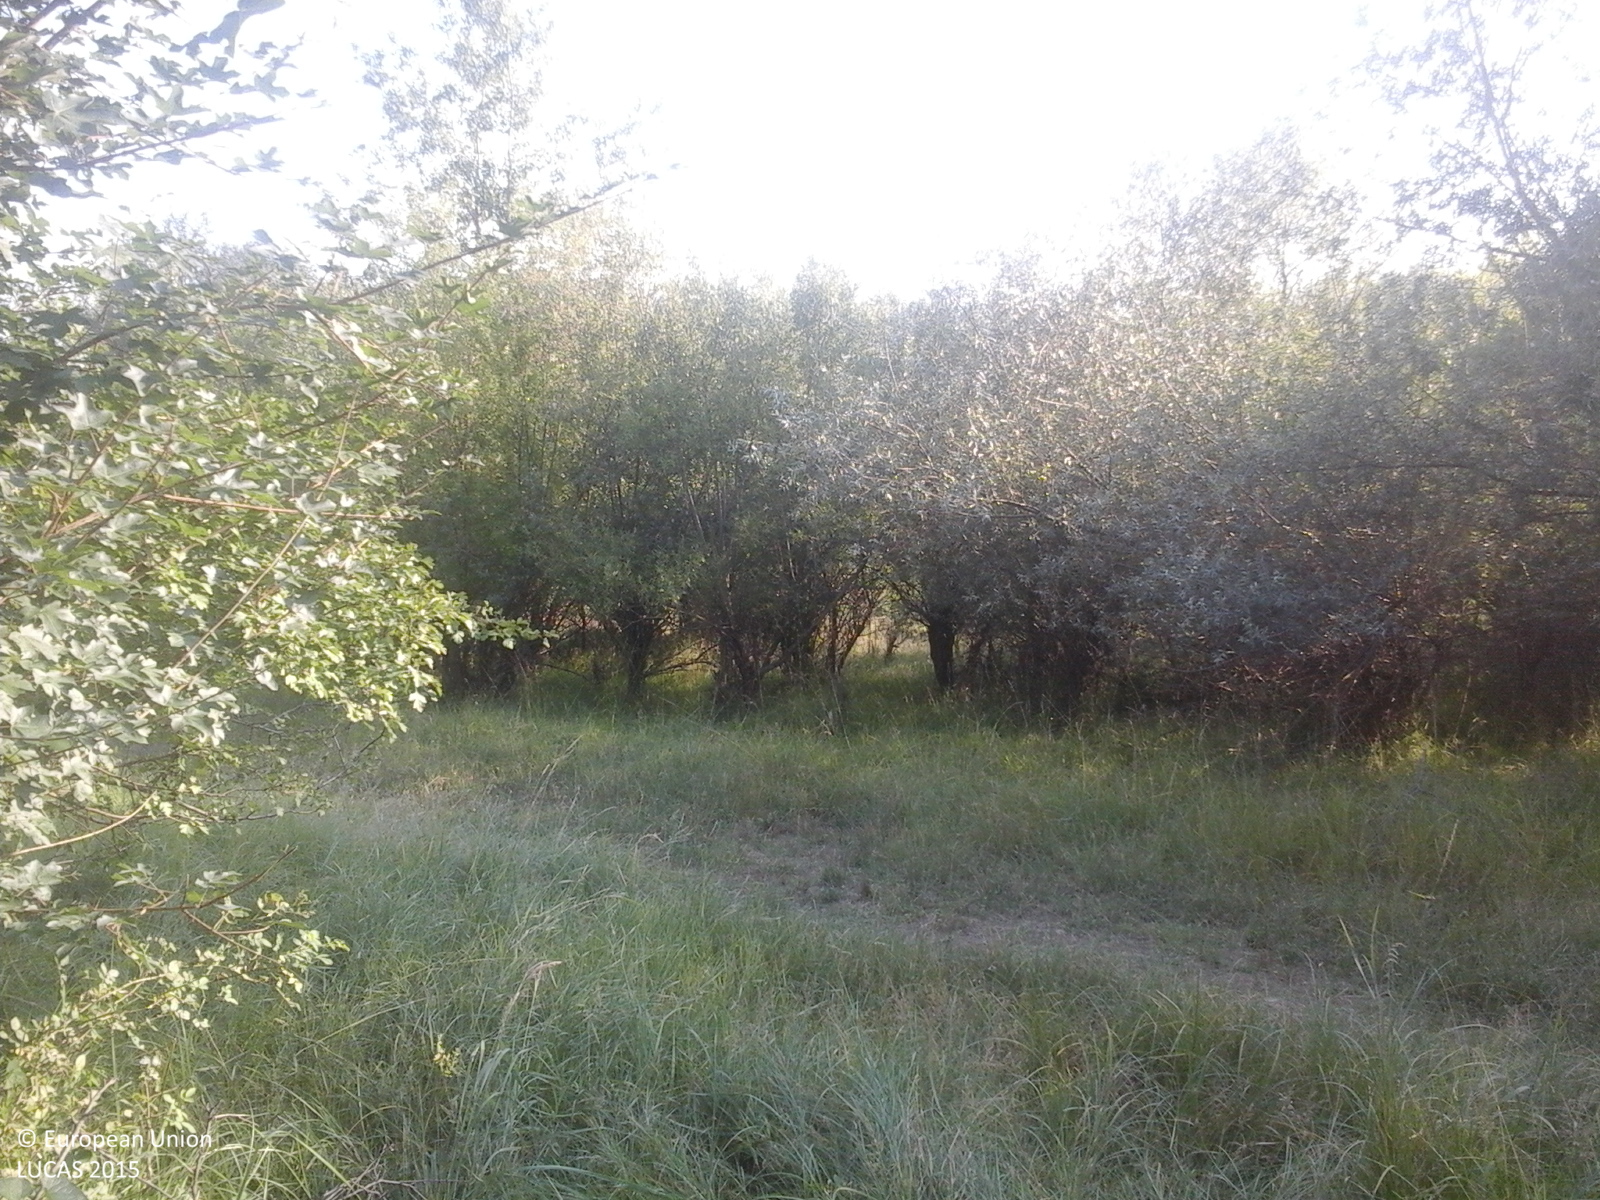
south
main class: Grassland
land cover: Grassland with sparse tree/shrub cover
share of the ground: > 75 %
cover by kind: herbaceous plants 85 %, shrubs 10 %, broadleaved forest trees 5 %
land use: Semi-natural and natural areas not in use
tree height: > 5 m
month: July
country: RO
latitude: 44.5224
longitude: 24.7080
